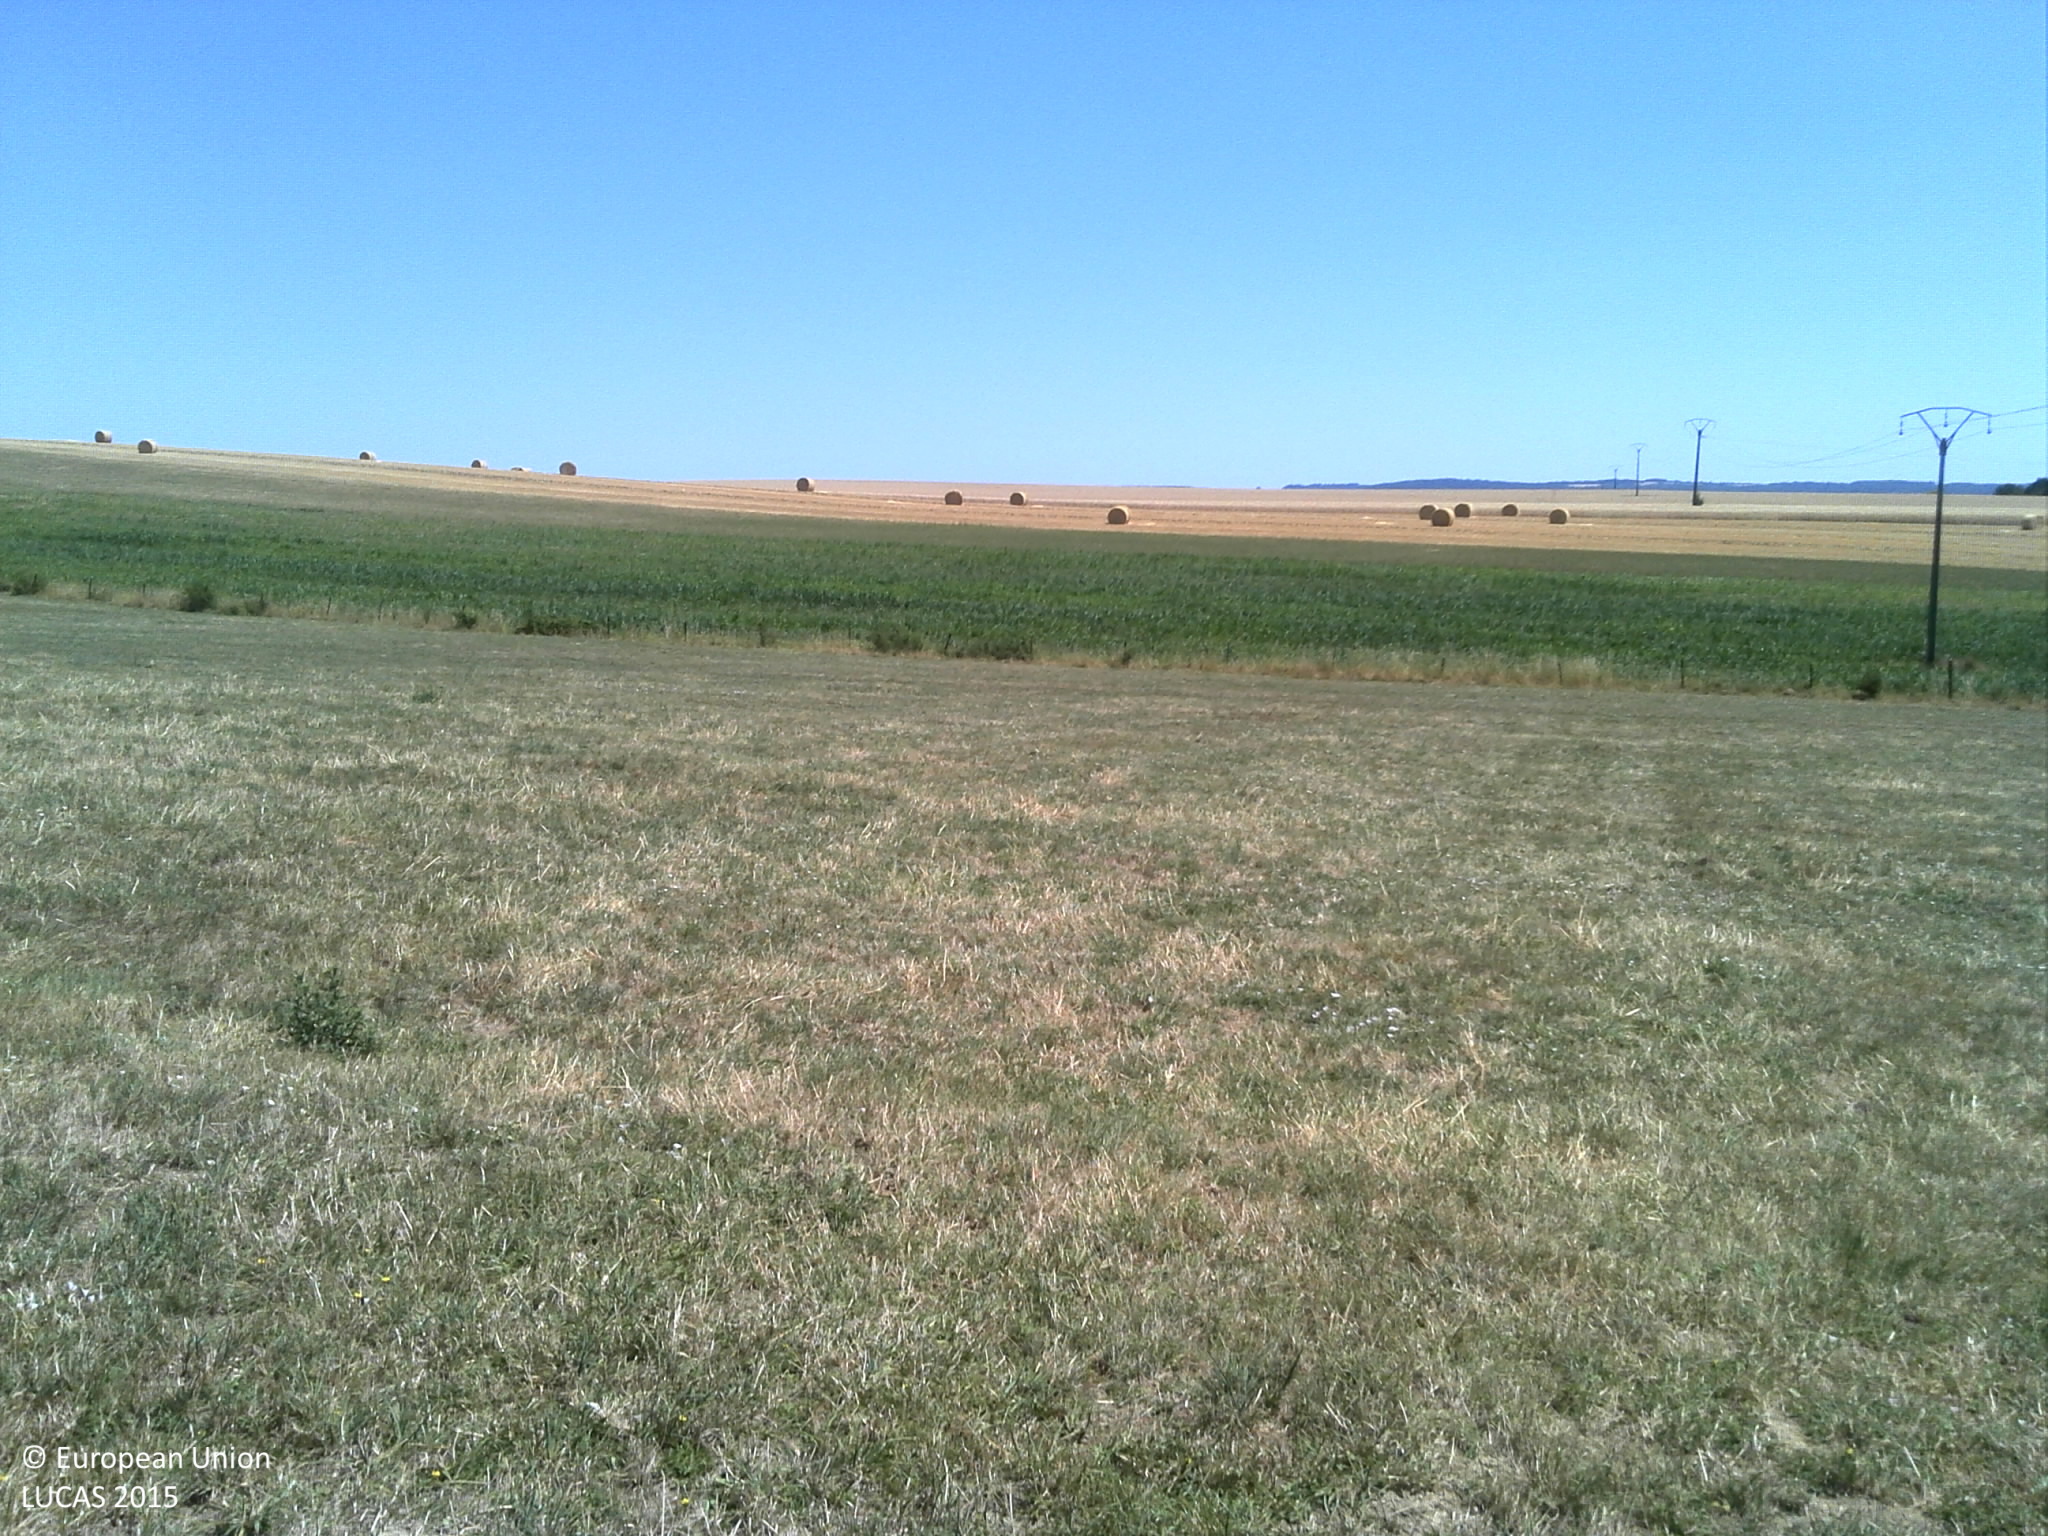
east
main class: Grassland
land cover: Grassland without tree/shrub cover
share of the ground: > 75 %
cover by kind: herbaceous plants 100 %
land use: Agriculture (excluding fallow land and kitchen gardens)
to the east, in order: Grassland without tree/shrub cover; Fences; Grass margins; Maize; Grassland without tree/shrub cover; Barley
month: July
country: FR
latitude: 49.4559
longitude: 6.2334
